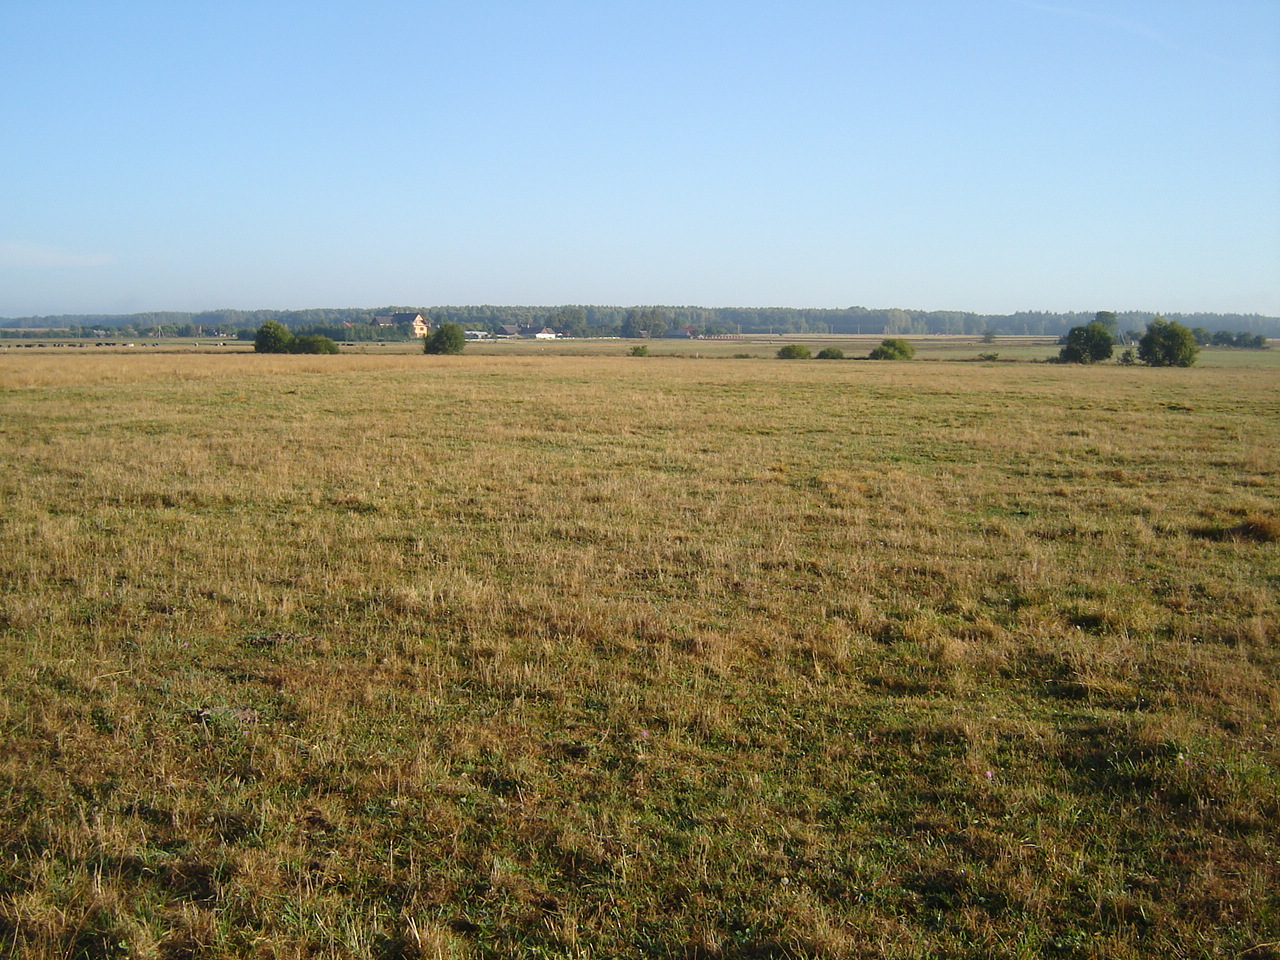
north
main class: Grassland
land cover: Grassland without tree/shrub cover
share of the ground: > 75 %
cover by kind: herbaceous plants 100 %
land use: Agriculture (excluding fallow land and kitchen gardens)
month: September
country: LT
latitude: 54.2383
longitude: 24.9827
